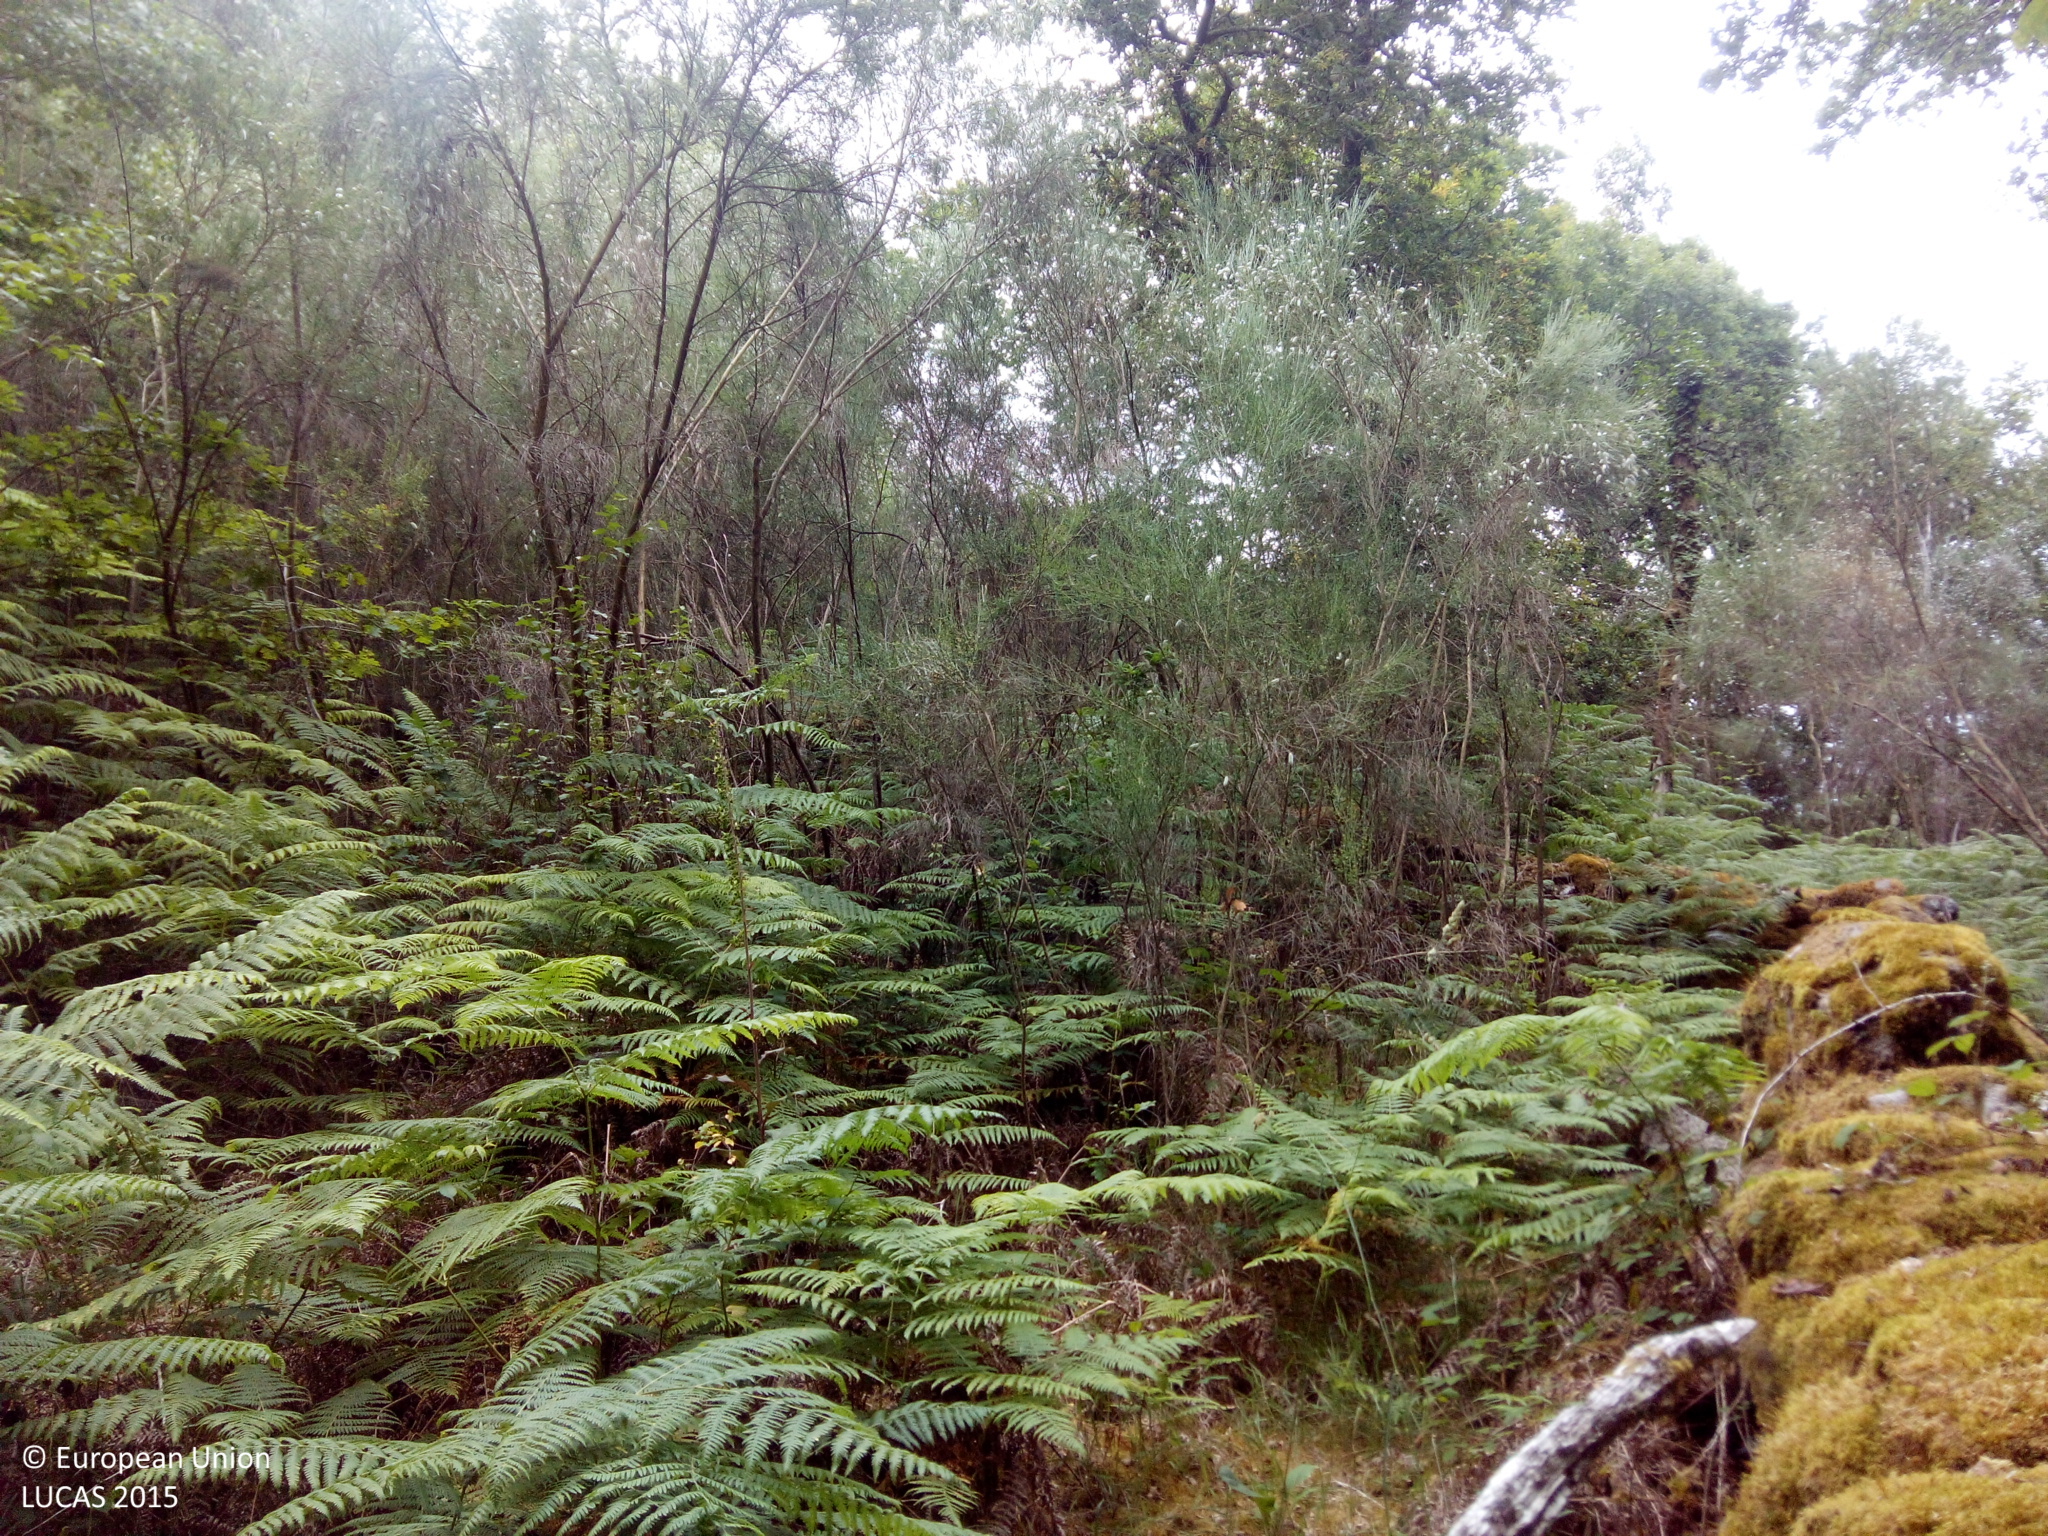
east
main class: Shrubland
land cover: Shrubland without tree cover
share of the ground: 10 - 25 %
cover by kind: consolidated bare surface 80 %, shrubs 20 %
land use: Semi-natural and natural areas not in use
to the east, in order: Shrubland without tree cover; Rock outcrops; Shrubland without tree cover; Tracks; Shrubland without tree cover; Rock outcrops; Shrubland without tree cover
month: July
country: ES
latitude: 42.2742
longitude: -8.2382
